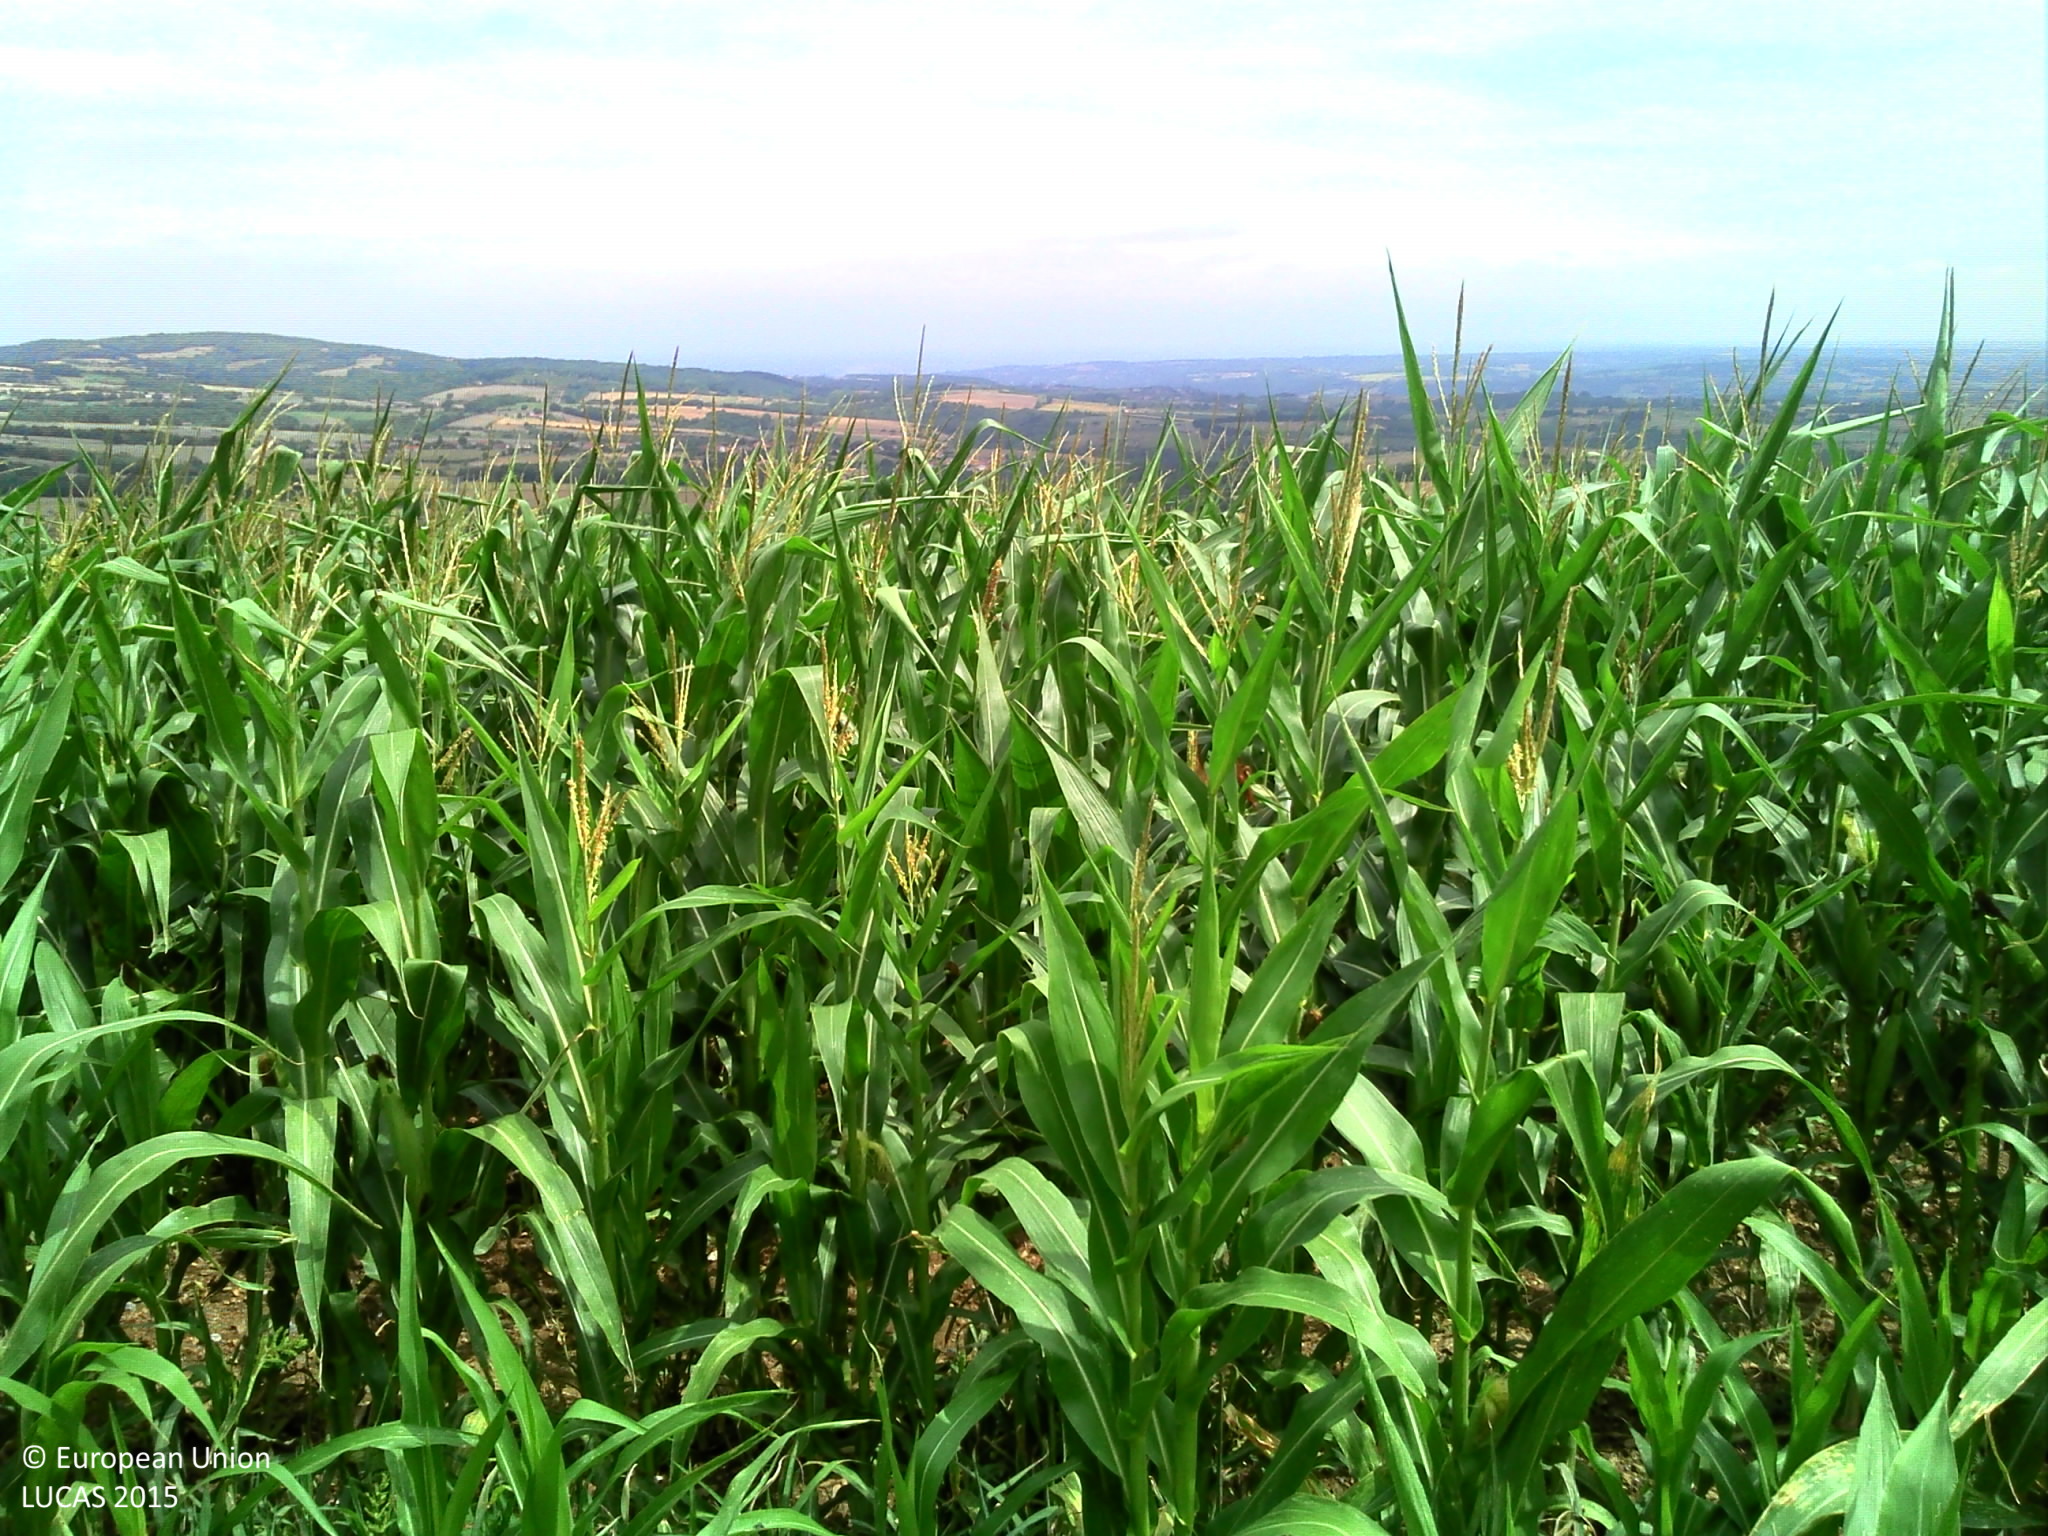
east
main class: Cropland
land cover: Maize
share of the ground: > 75 %
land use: Agriculture (excluding fallow land and kitchen gardens)
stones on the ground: 25 - 50 %
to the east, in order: Maize; Grassland without tree/shrub cover; Maize; Grassland without tree/shrub cover; Maize; Abandoned hedges; Grassland without tree/shrub cover
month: August
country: FR
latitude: 45.4986
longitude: 4.7188
